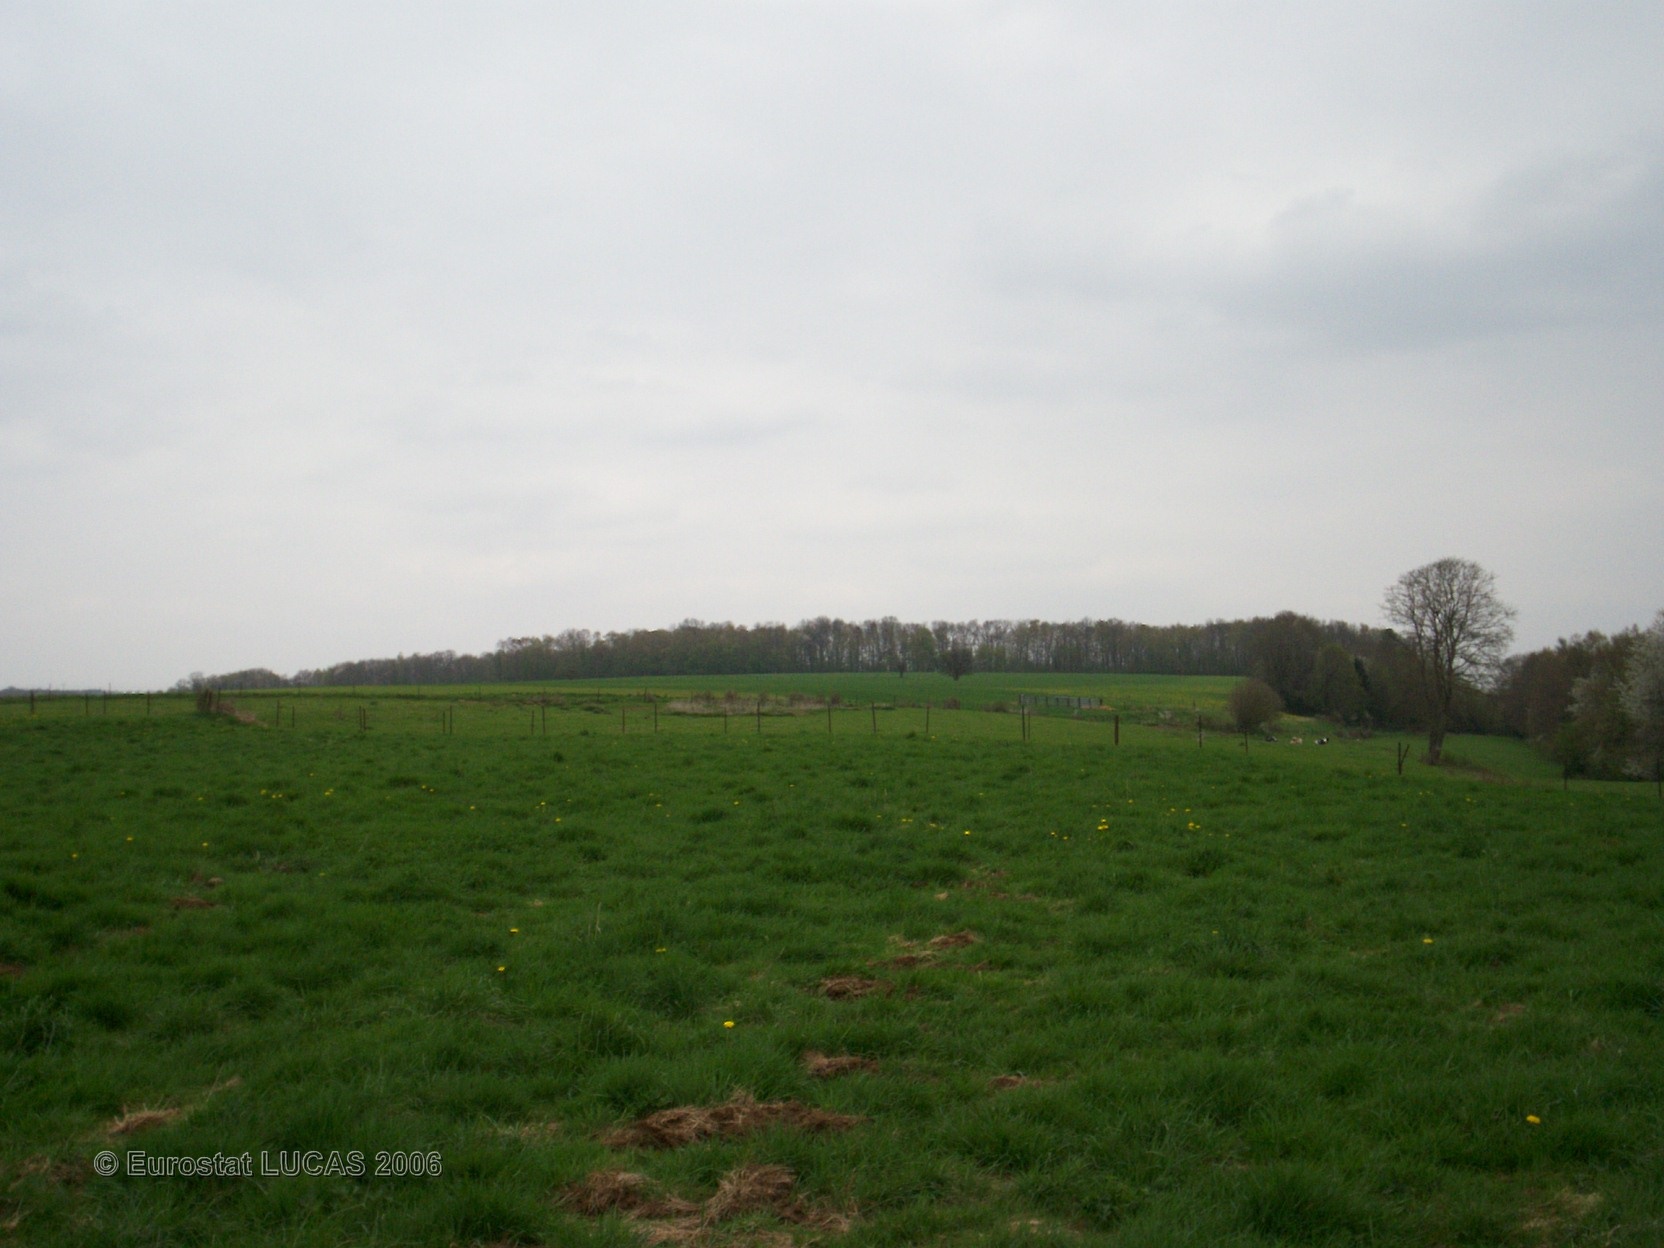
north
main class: Grassland
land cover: Grassland without tree/shrub cover
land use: Agriculture (excluding fallow land and kitchen gardens)
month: April
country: FR
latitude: 49.7471
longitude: 4.5421
